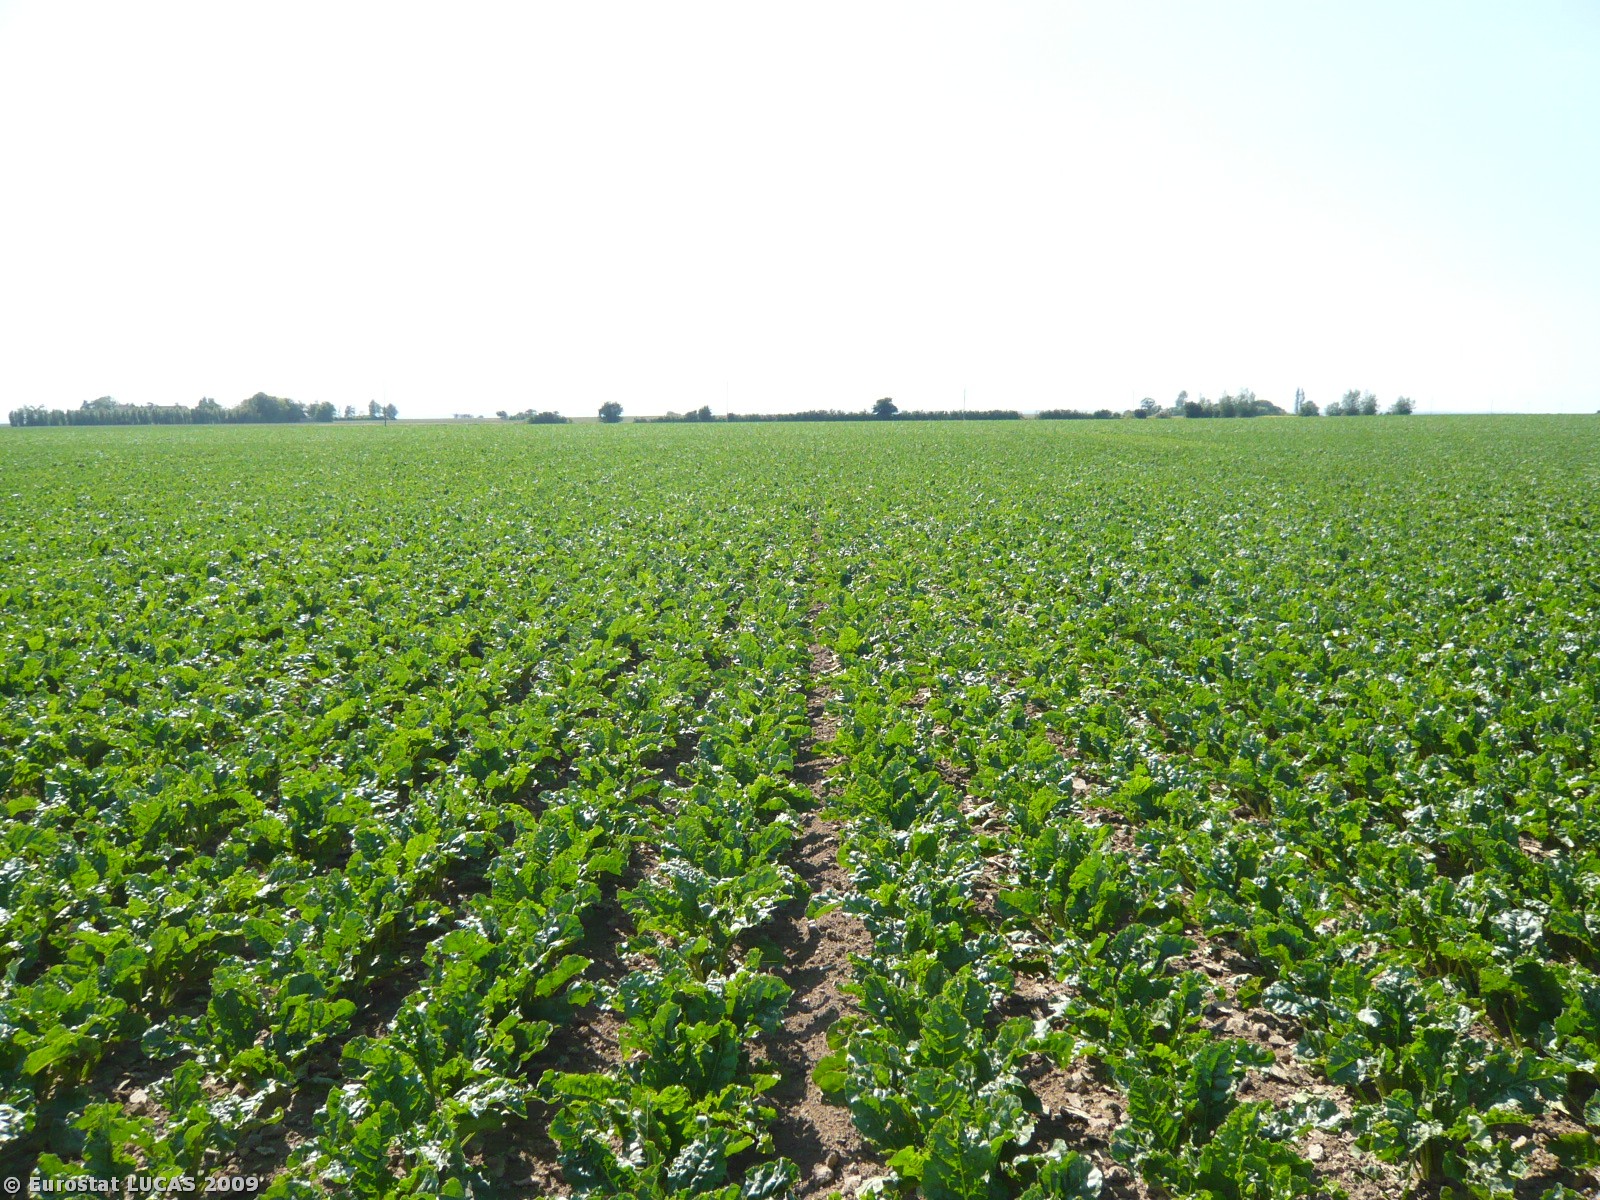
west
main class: Cropland
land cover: Sugar beet
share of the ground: > 75 %
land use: Agriculture (excluding fallow land and kitchen gardens)
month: June
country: DK
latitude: 54.8825
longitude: 11.6667
